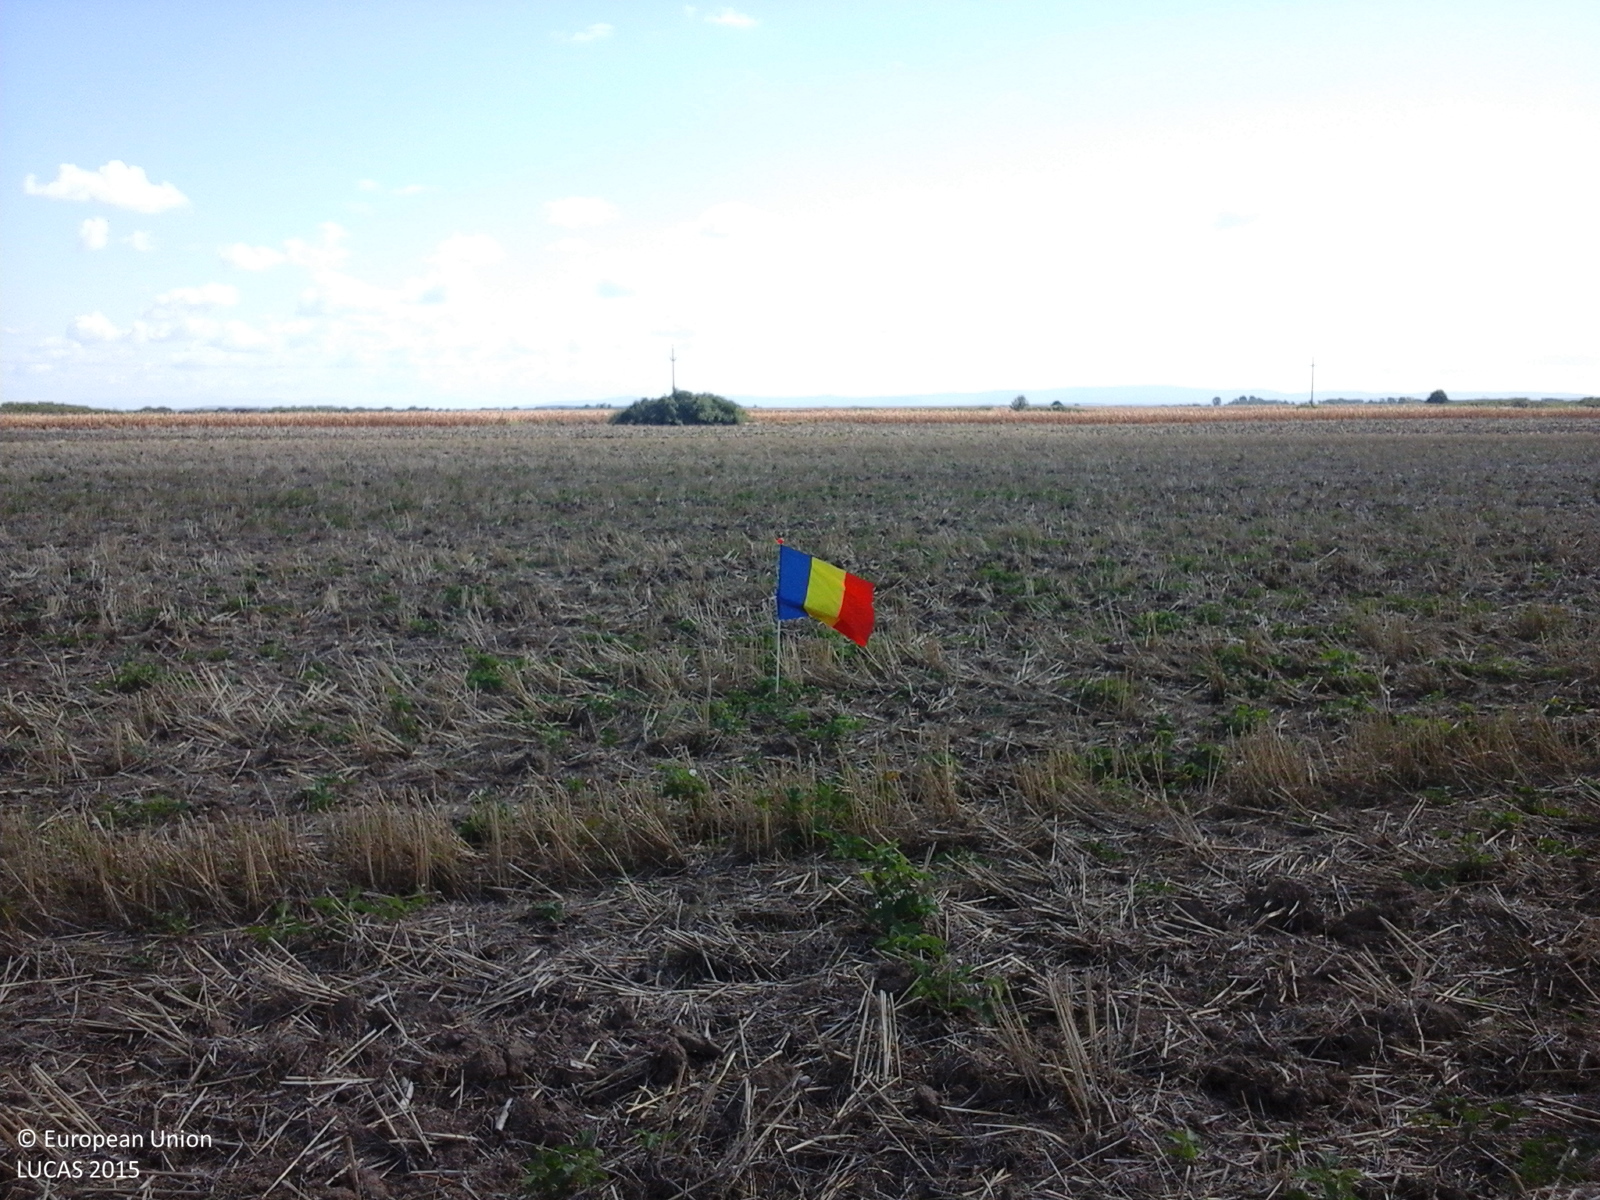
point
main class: Cropland
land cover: Durum wheat
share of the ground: 25 - 50 %
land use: Agriculture (excluding fallow land and kitchen gardens)
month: September
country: RO
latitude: 47.5938
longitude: 22.7080
